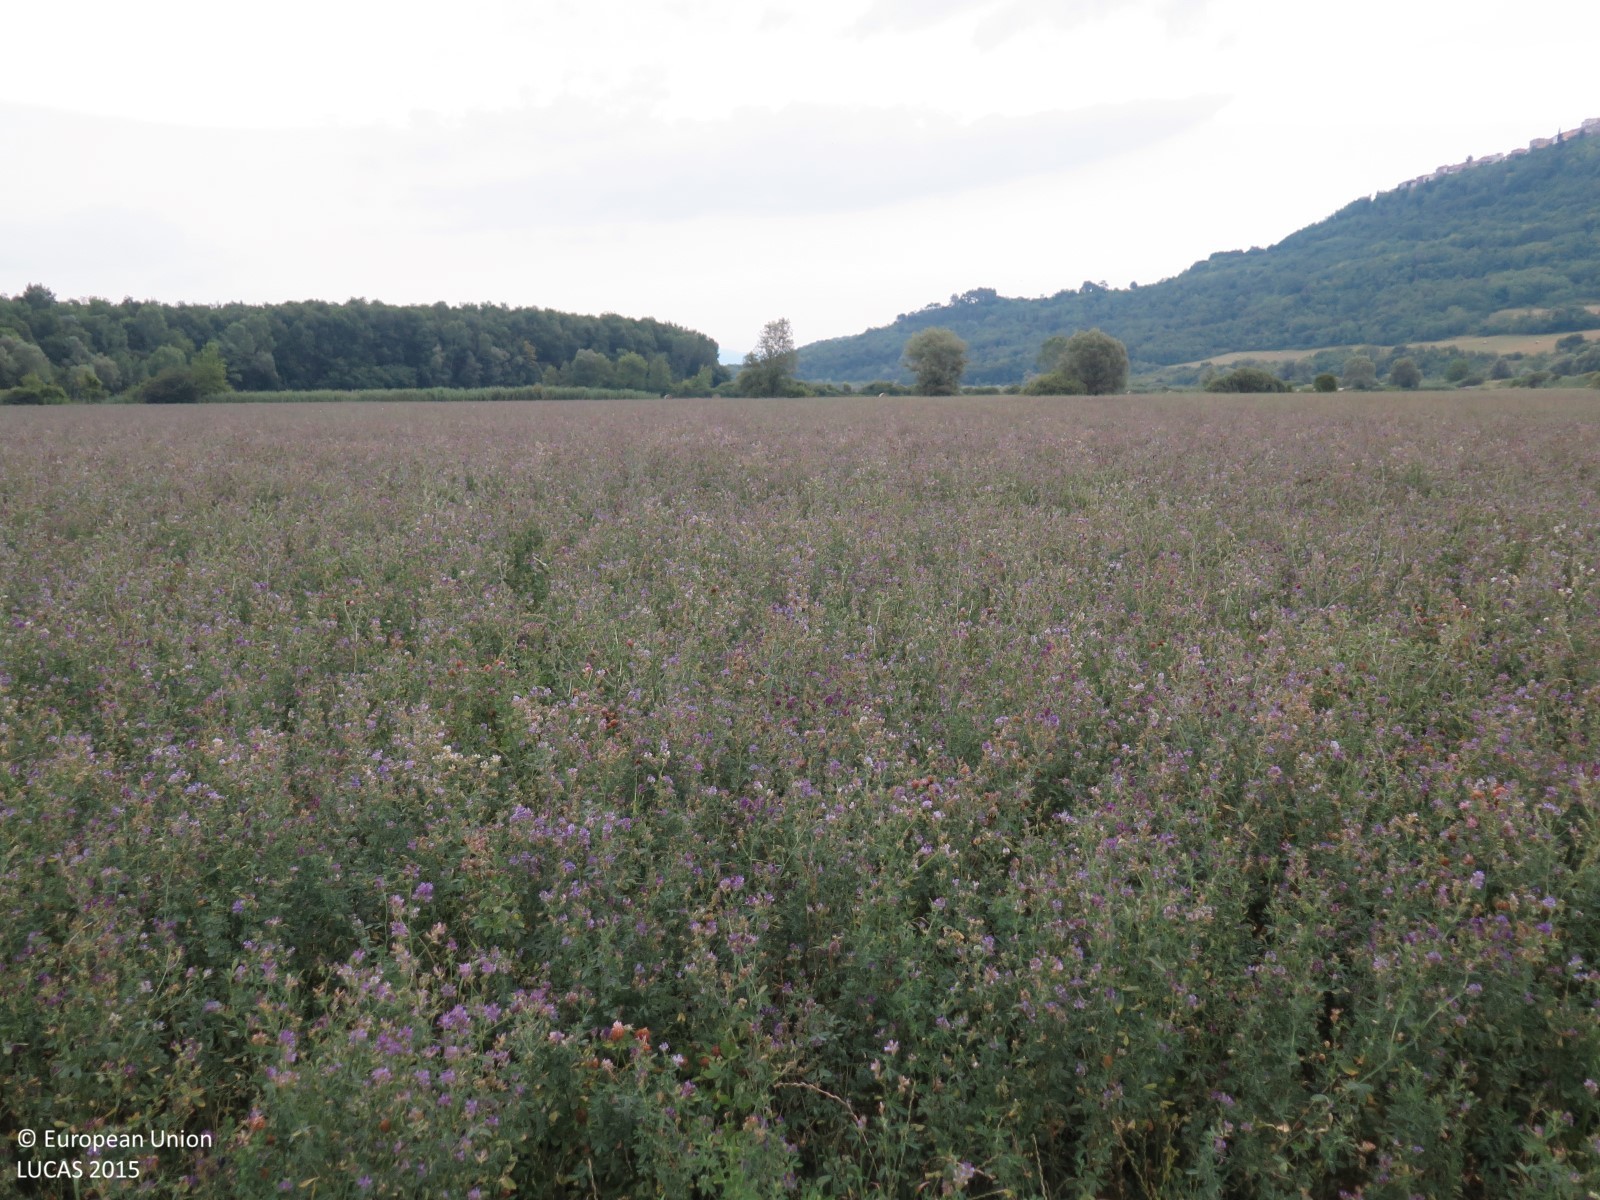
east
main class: Cropland
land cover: Lucerne
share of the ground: > 75 %
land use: Agriculture (excluding fallow land and kitchen gardens)
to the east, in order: Lucerne; Grass margins; Ditches and canals; Grass margins; Temporary grasslands
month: July
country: HR
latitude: 45.3454
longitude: 13.8111
